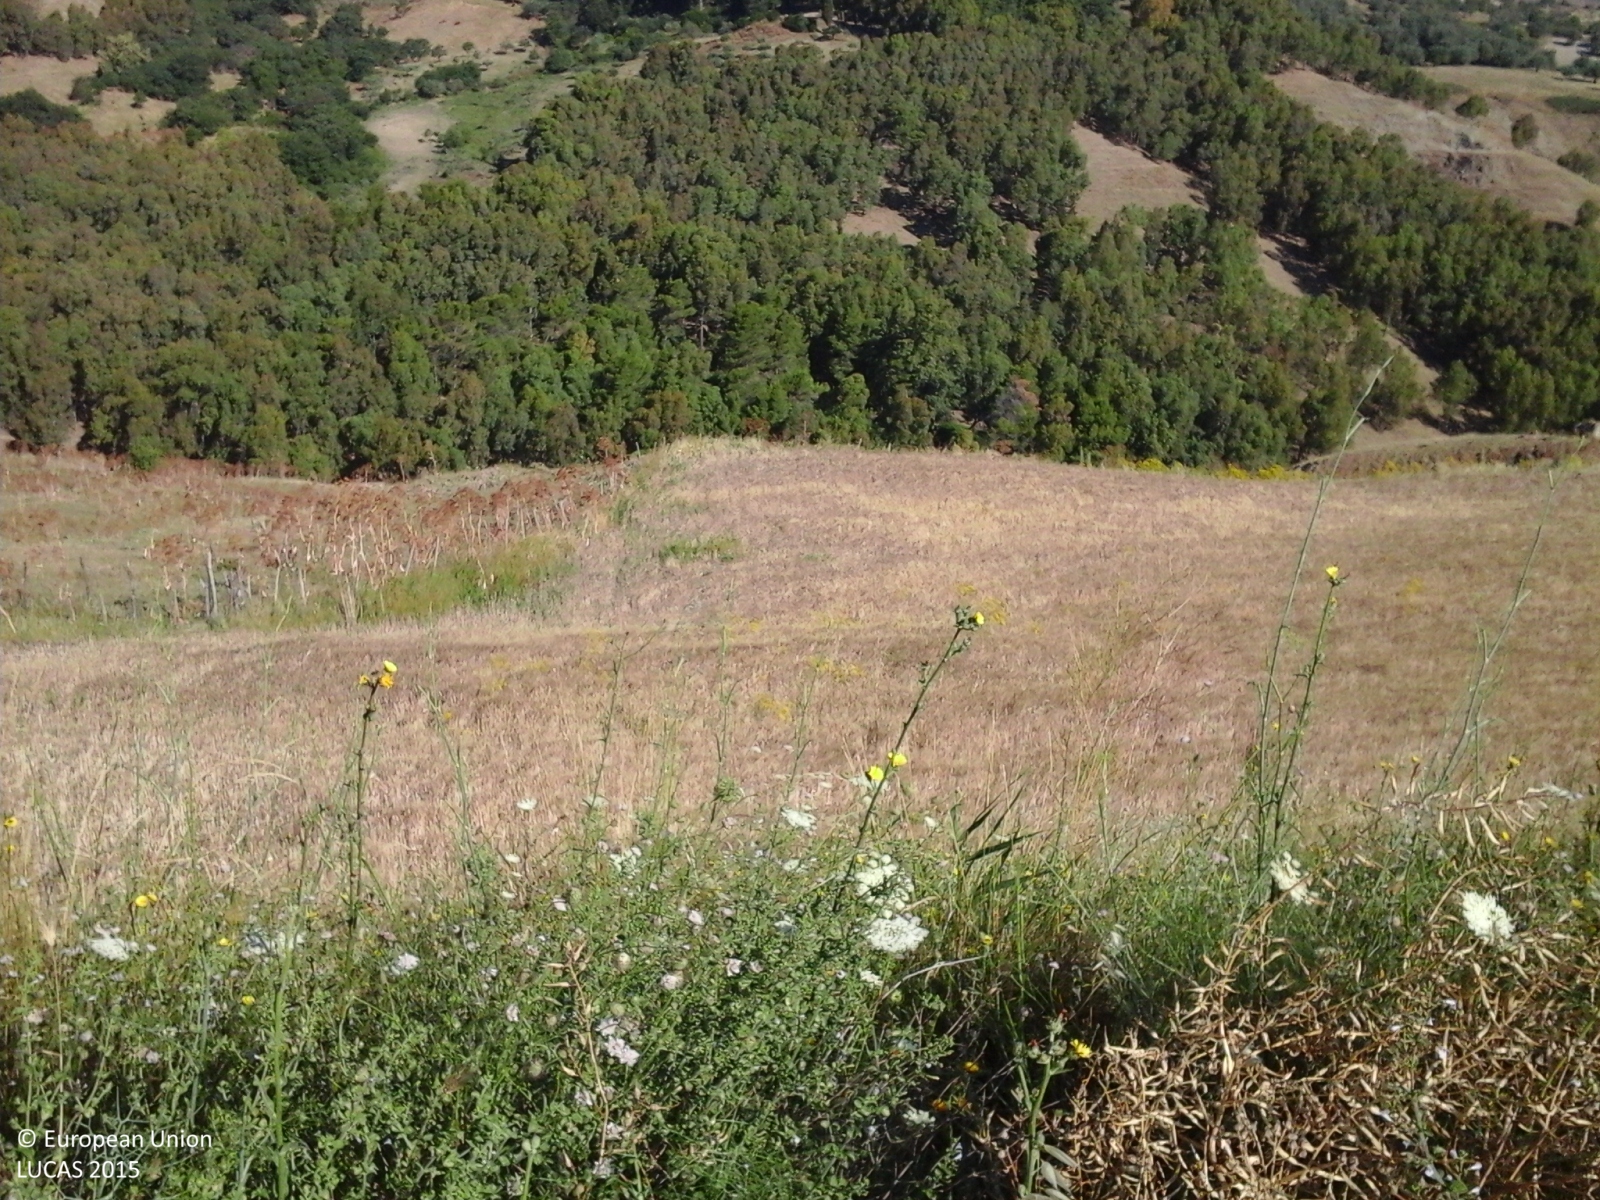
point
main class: Cropland
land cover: Durum wheat
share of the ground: > 75 %
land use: Agriculture (excluding fallow land and kitchen gardens)
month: June
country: IT
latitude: 37.5965
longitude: 14.2839
